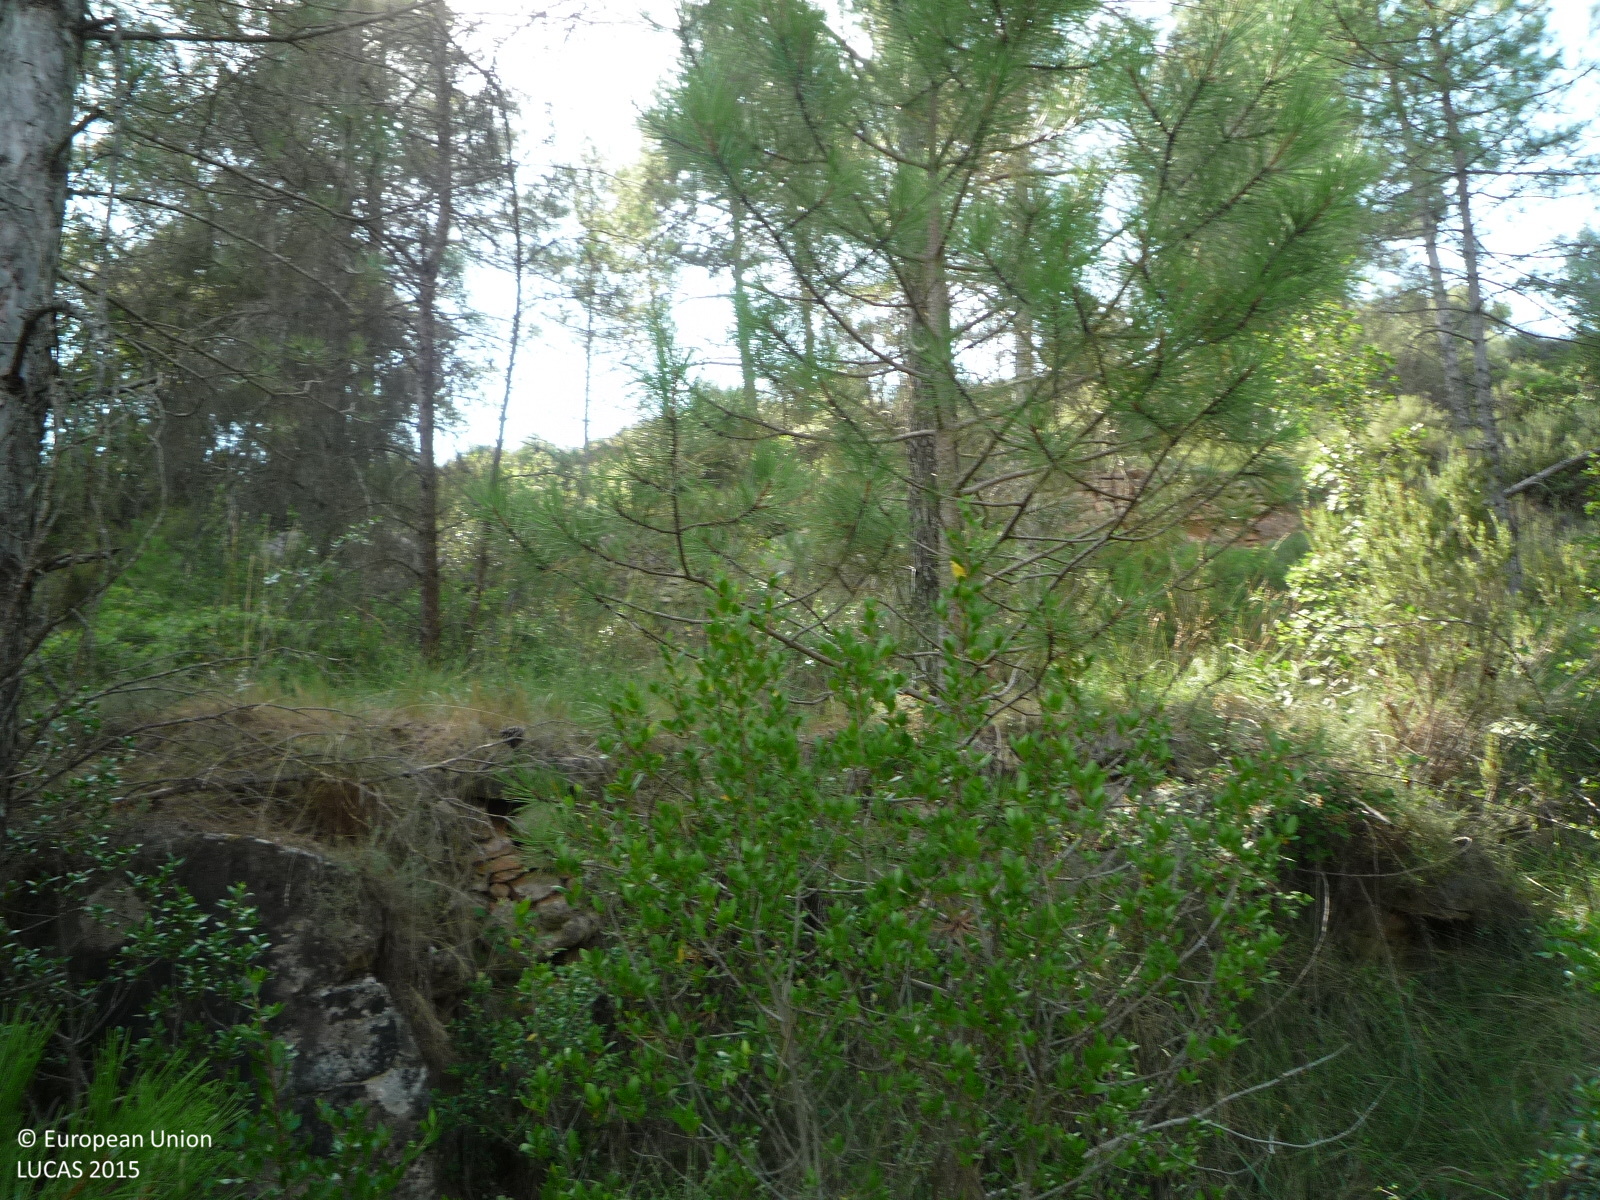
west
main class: Woodland
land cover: Pine dominated mixed woodland
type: coniferous forest of the mediterranean region
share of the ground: > 75 %
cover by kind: coniferous forest trees 70 %, broadleaved forest trees 30 %
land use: Semi-natural and natural areas not in use
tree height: > 5 m
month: July
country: ES
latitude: 41.7666
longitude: 1.6785
